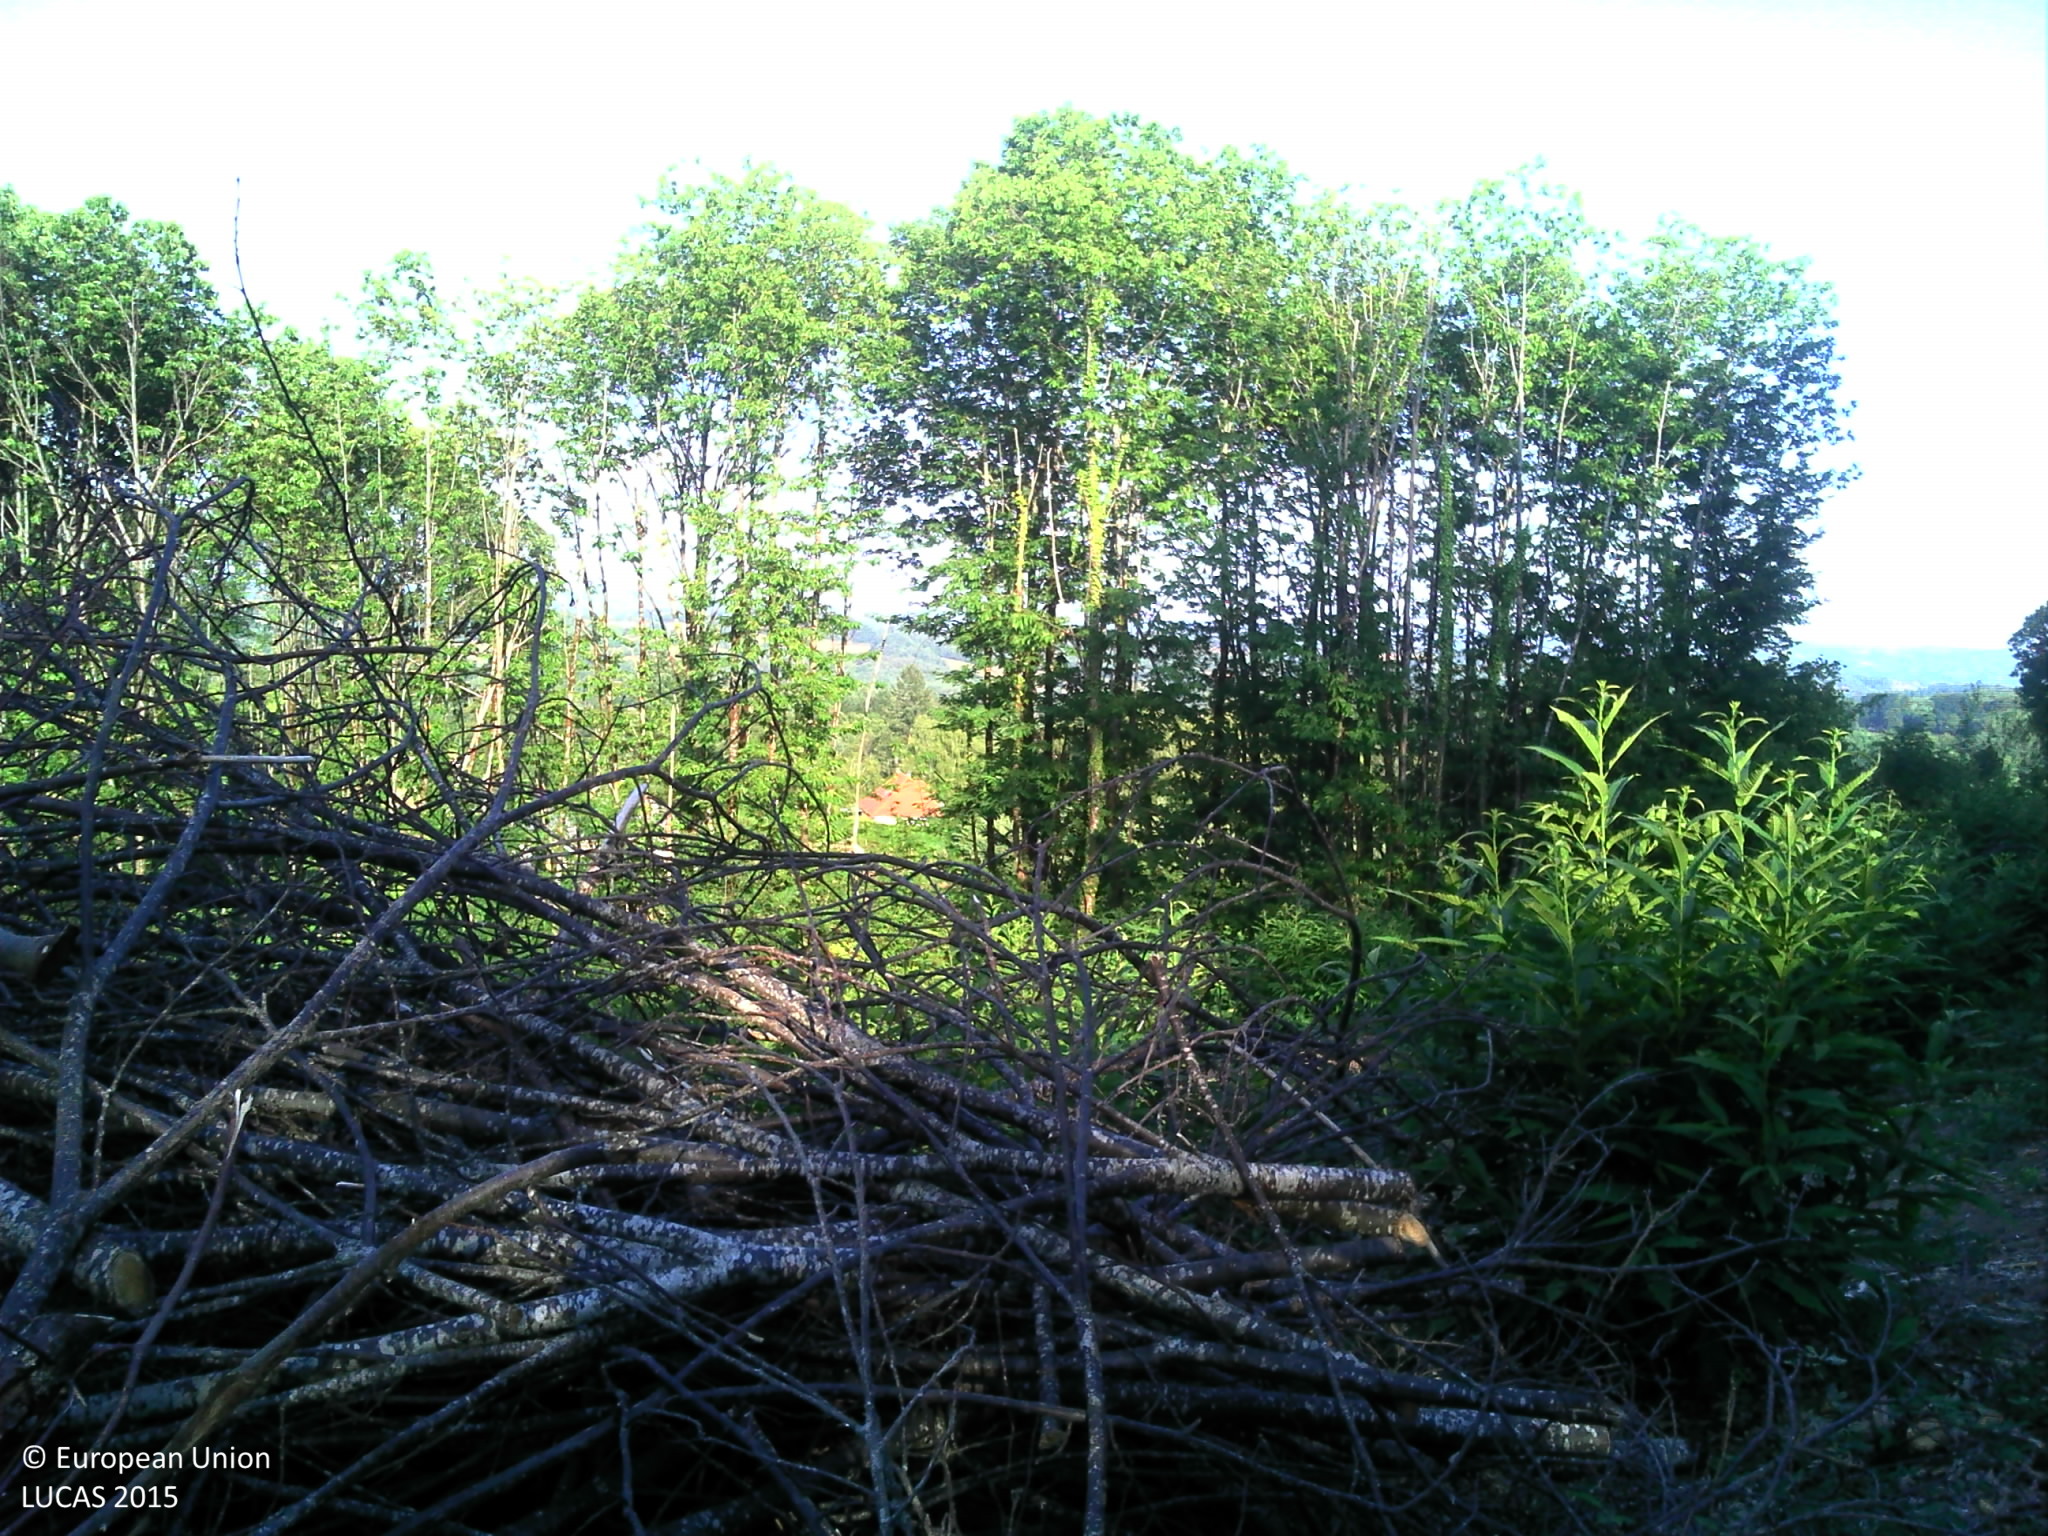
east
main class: Woodland
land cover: Broadleaved woodland
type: thermophilous deciduous forest
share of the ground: 50 - 75 %
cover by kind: broadleaved forest trees 50 %, unconsolidated bare surface 50 %
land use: Forestry
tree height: > 5 m
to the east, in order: Broadleaved woodland; Tracks; Grass margins; Broadleaved woodland; Fences; Shrubland without tree cover; Artificial constructions in urban areas; Abandoned hedges; Fences; Other mixed woodland; Grassland without tree/shrub cover
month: August
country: FR
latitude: 45.3034
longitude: 1.6931
